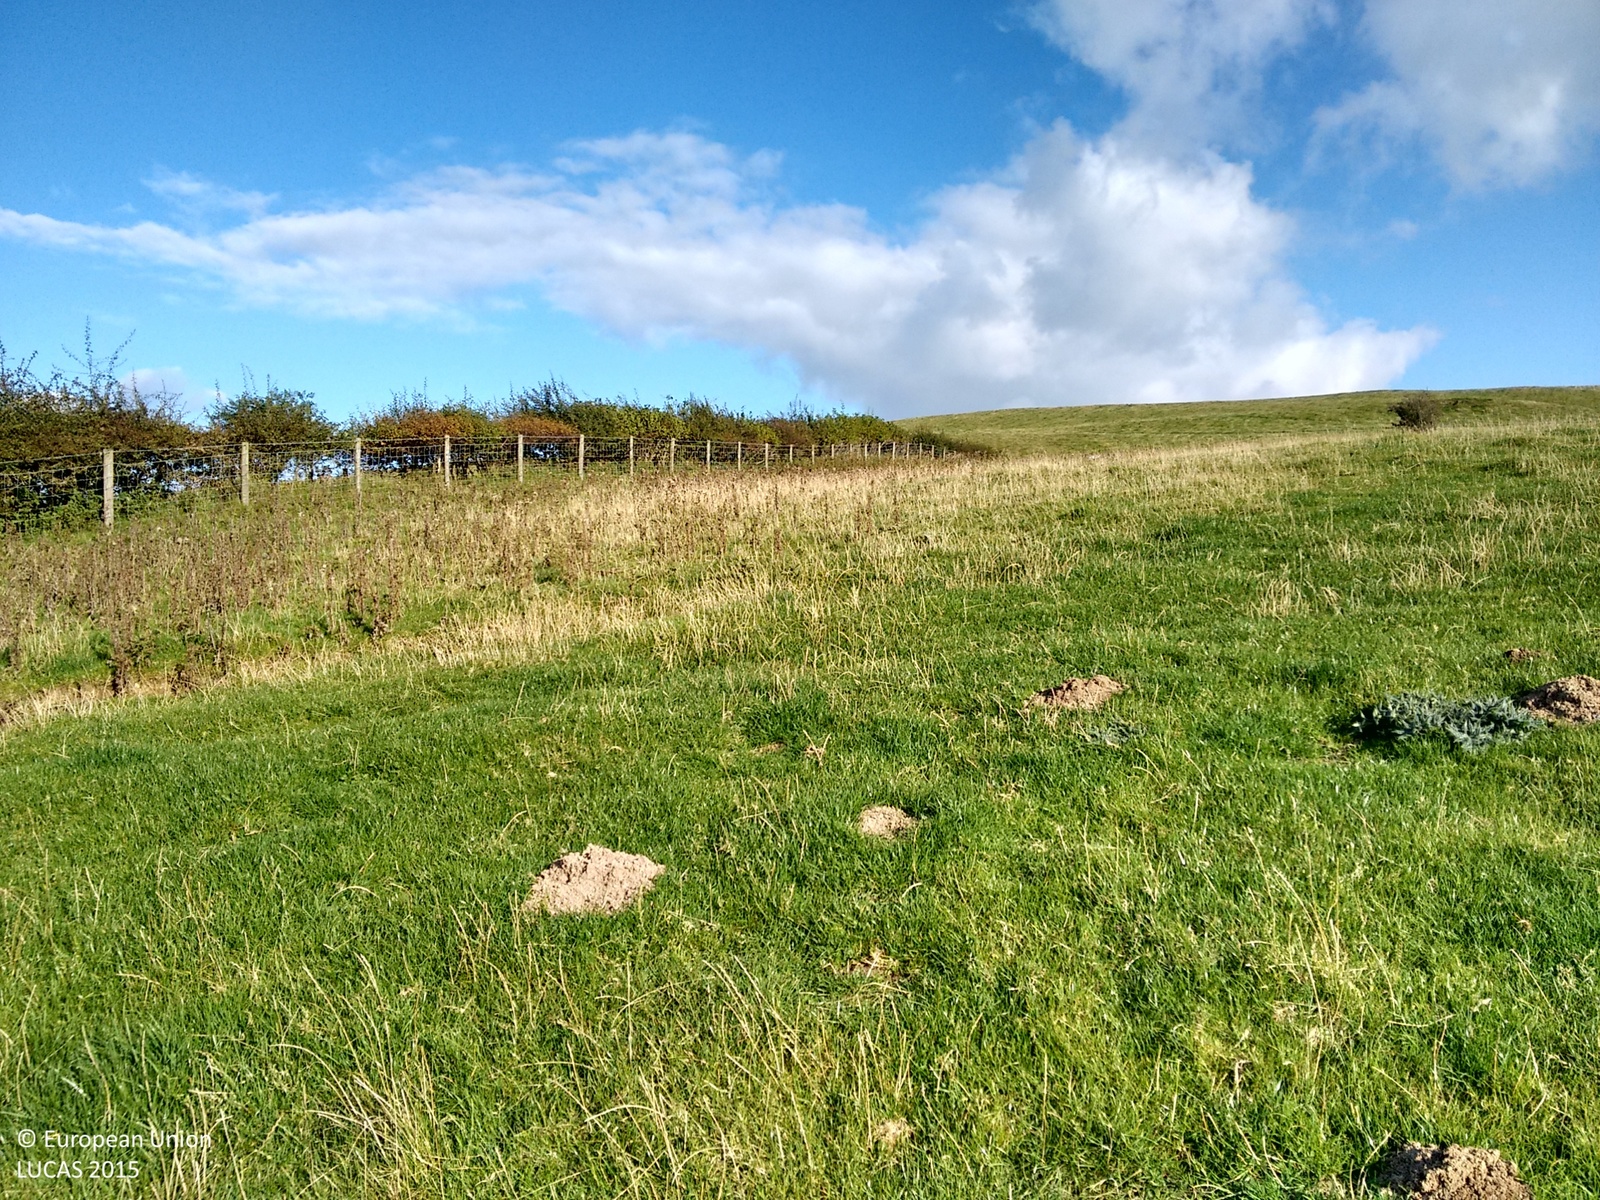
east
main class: Grassland
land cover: Grassland without tree/shrub cover
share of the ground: > 75 %
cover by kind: herbaceous plants 100 %
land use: Agriculture (excluding fallow land and kitchen gardens)
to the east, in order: Grassland without tree/shrub cover; Fences; Managed hedges; Fences; Grassland without tree/shrub cover; Fences; Grassland without tree/shrub cover
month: October
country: GB
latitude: 52.4213
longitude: -3.5098
